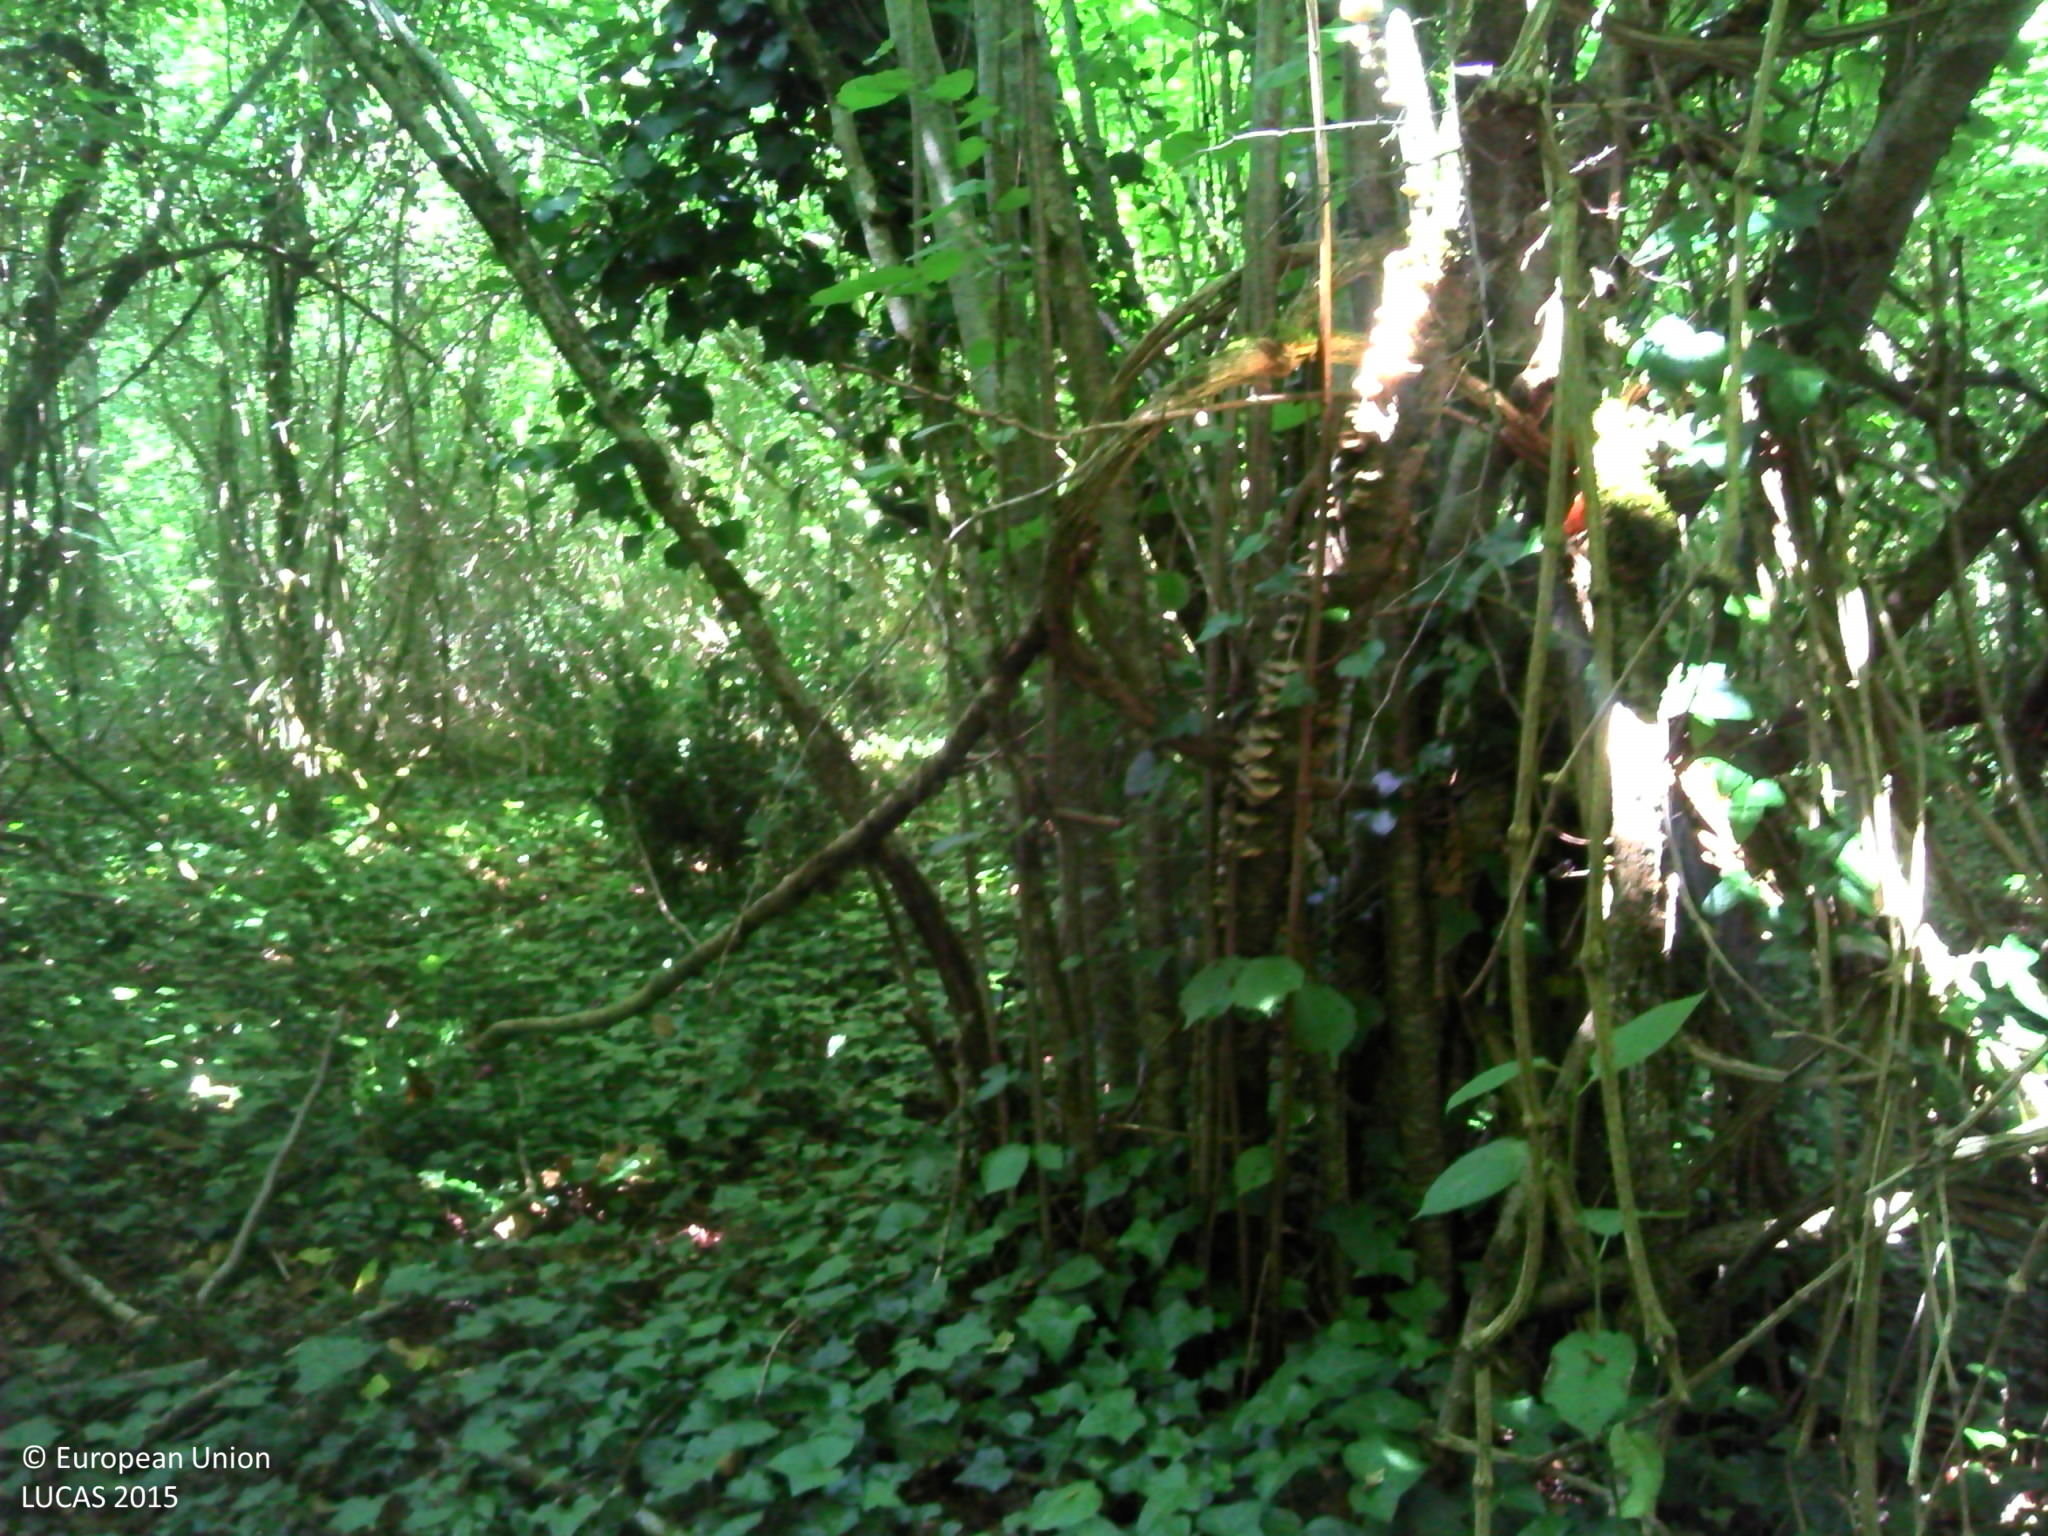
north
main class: Woodland
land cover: Broadleaved woodland
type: mesophytic deciduous forest
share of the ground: > 75 %
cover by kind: broadleaved forest trees 80 %, herbaceous plants 20 %
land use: Forestry
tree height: > 5 m
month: July
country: FR
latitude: 45.5159
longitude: -0.5835
